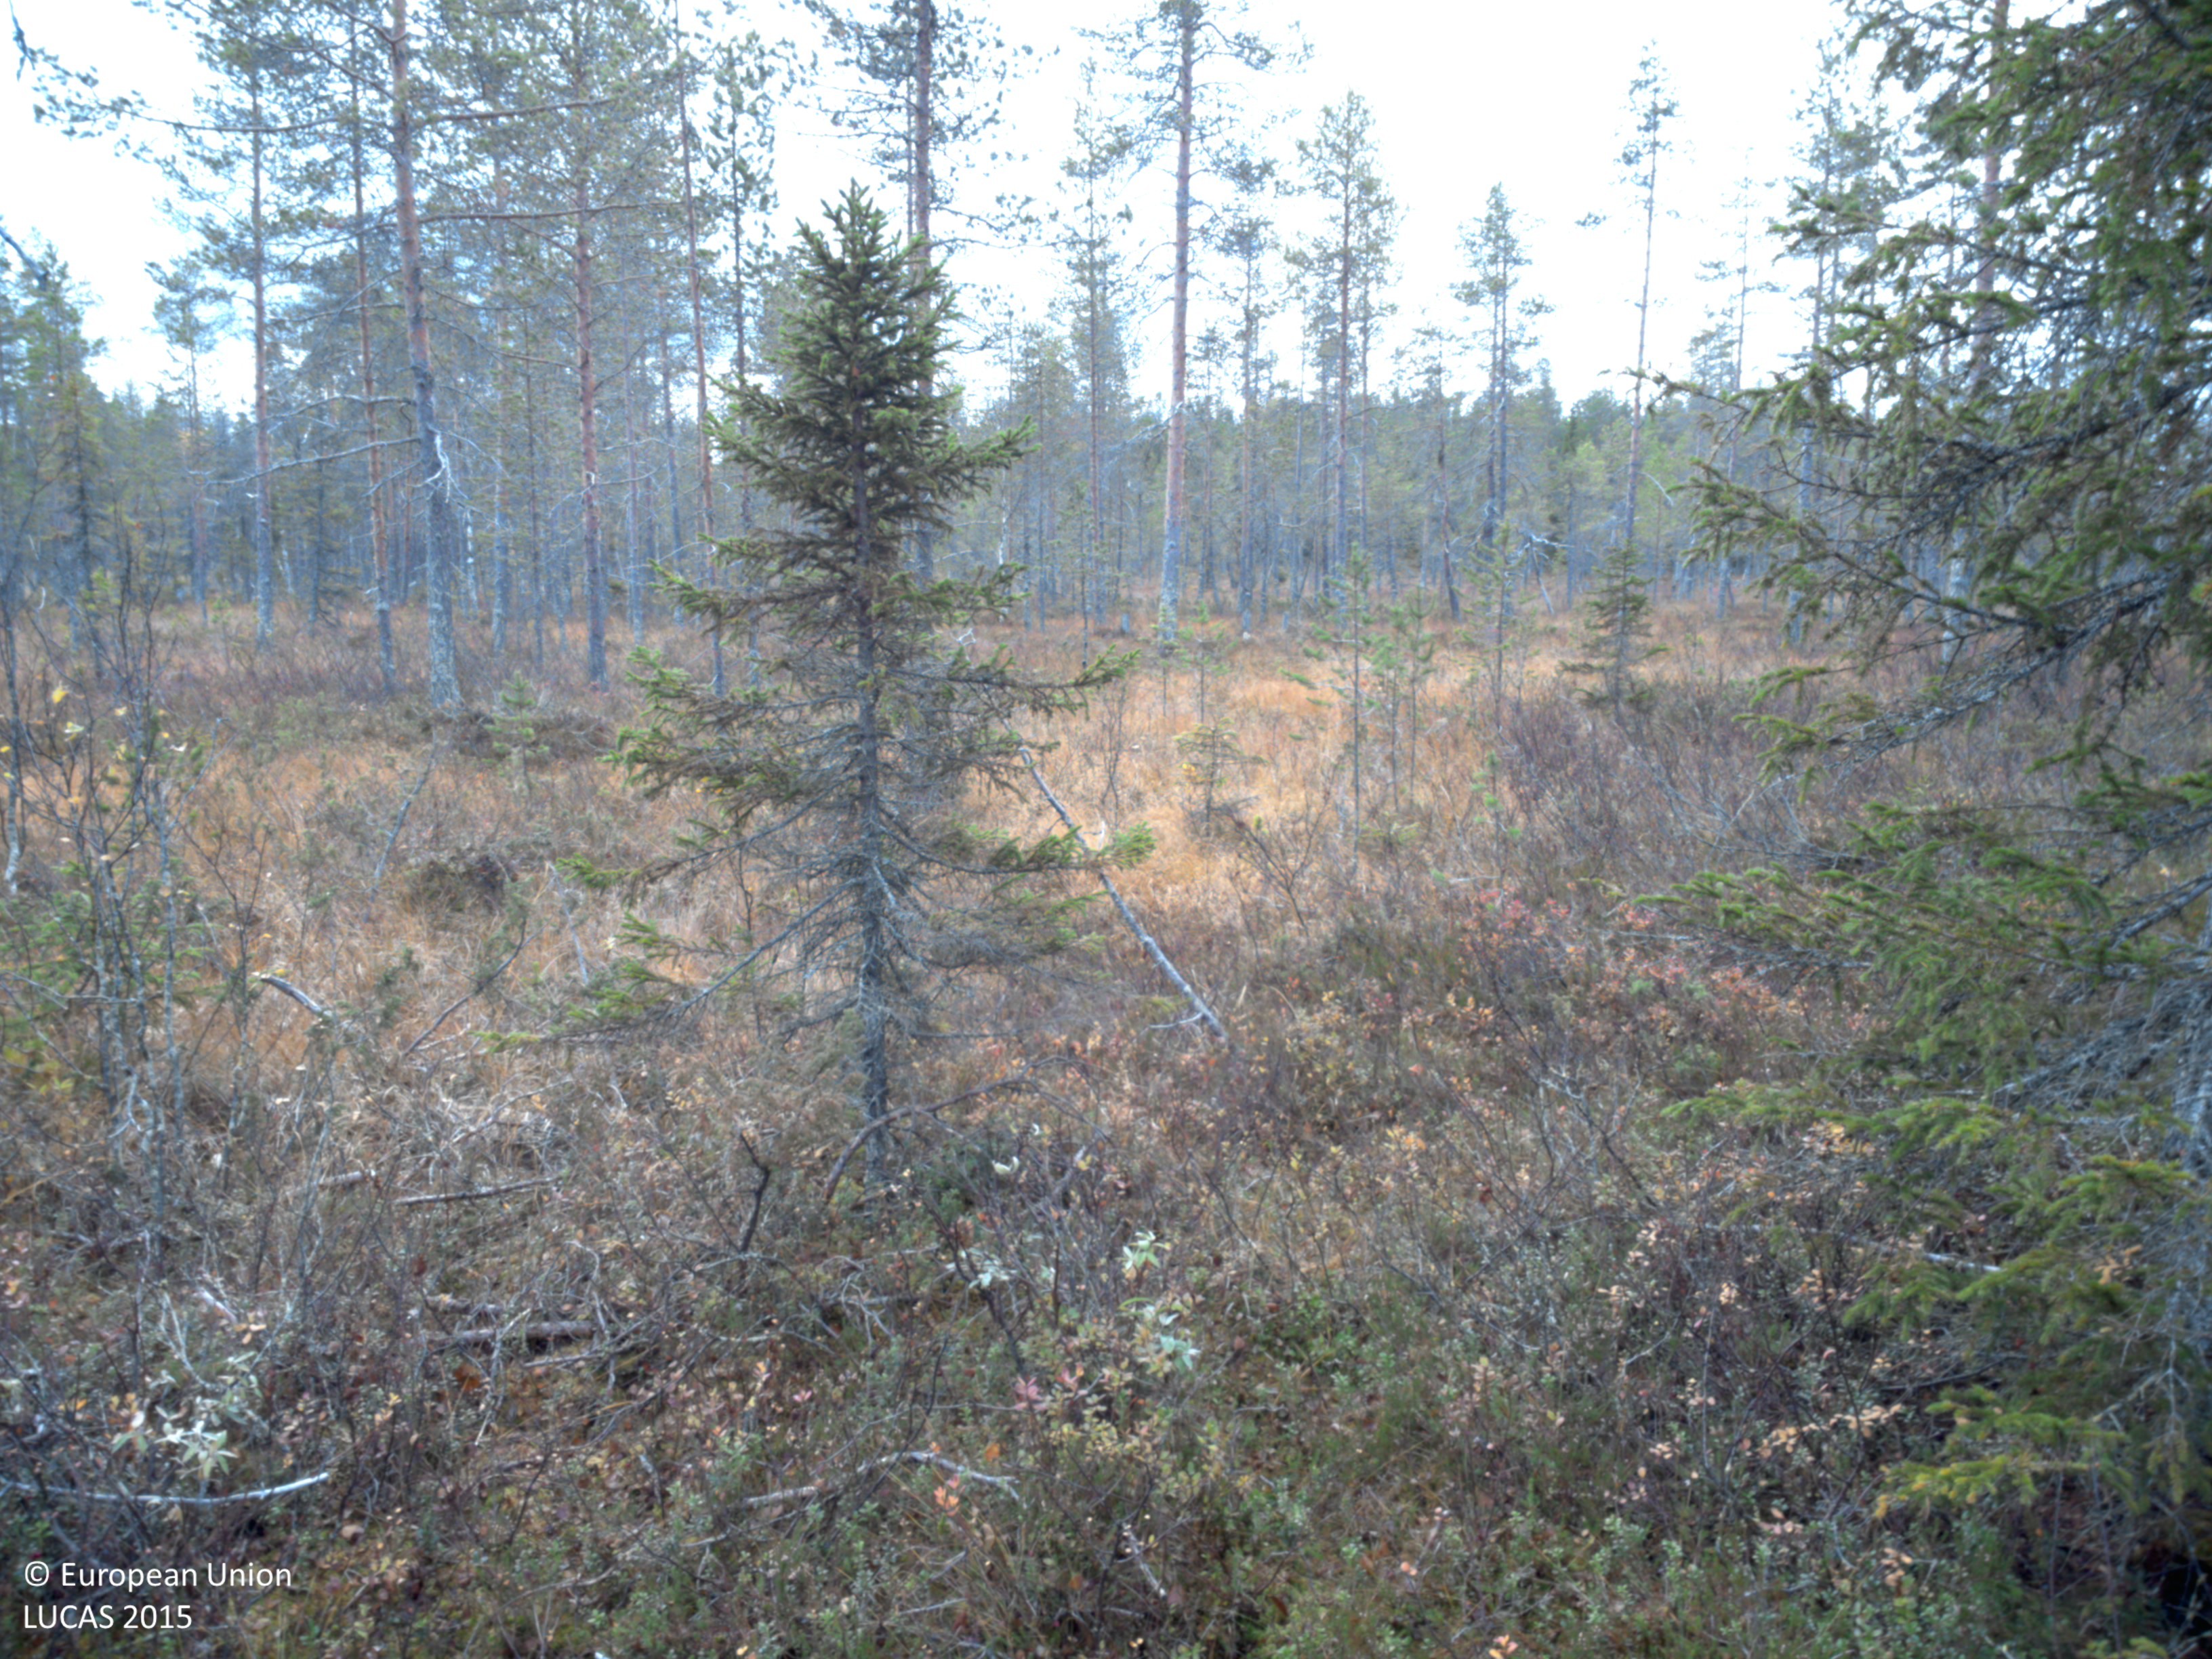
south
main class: Woodland
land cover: Pine dominated mixed woodland
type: mire and swamp forests
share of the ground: 25 - 50 %
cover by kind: coniferous forest trees 25 %, shrubs 25 %, lichens and mosses 25 %, herbaceous plants 15 %, broadleaved forest trees 10 %
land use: Forestry
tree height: > 5 m
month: October
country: SE
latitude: 64.6271
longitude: 18.1029
